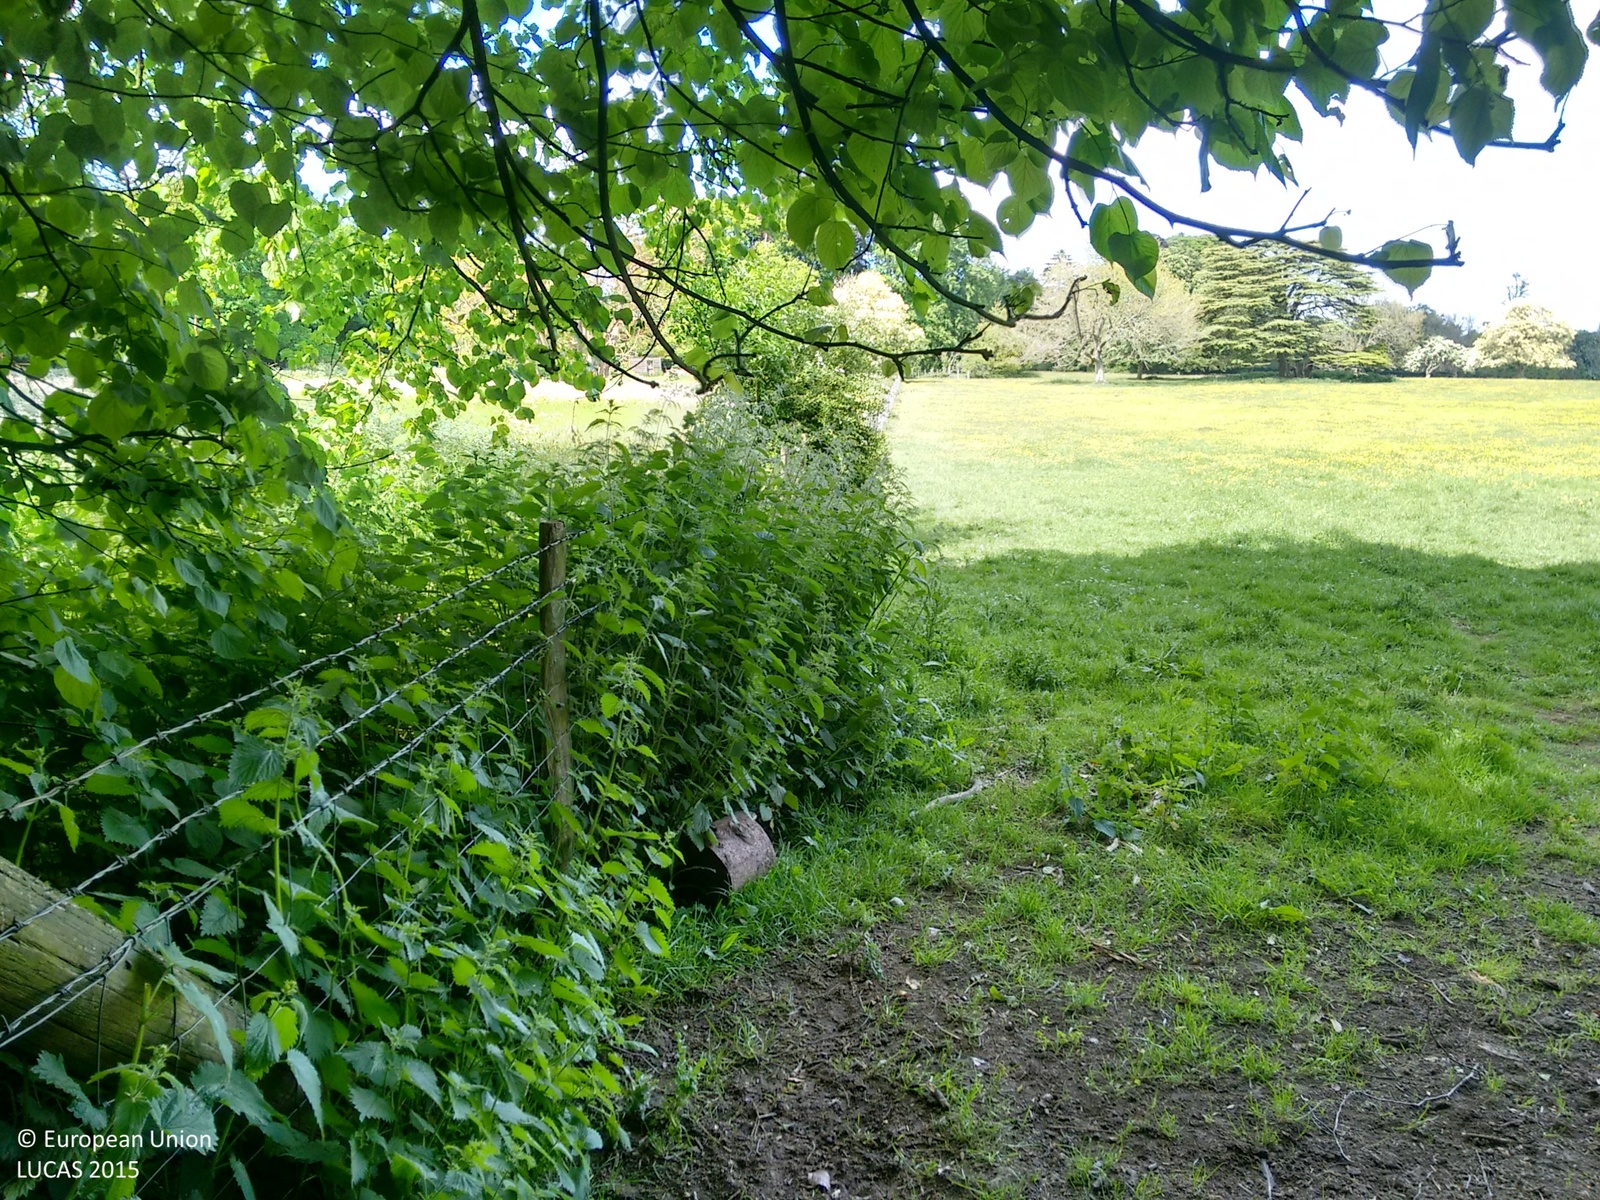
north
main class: Grassland
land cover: Grassland without tree/shrub cover
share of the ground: > 75 %
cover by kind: herbaceous plants 100 %
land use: Agriculture (excluding fallow land and kitchen gardens)
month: May
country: GB
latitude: 51.2340
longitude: 1.1699
